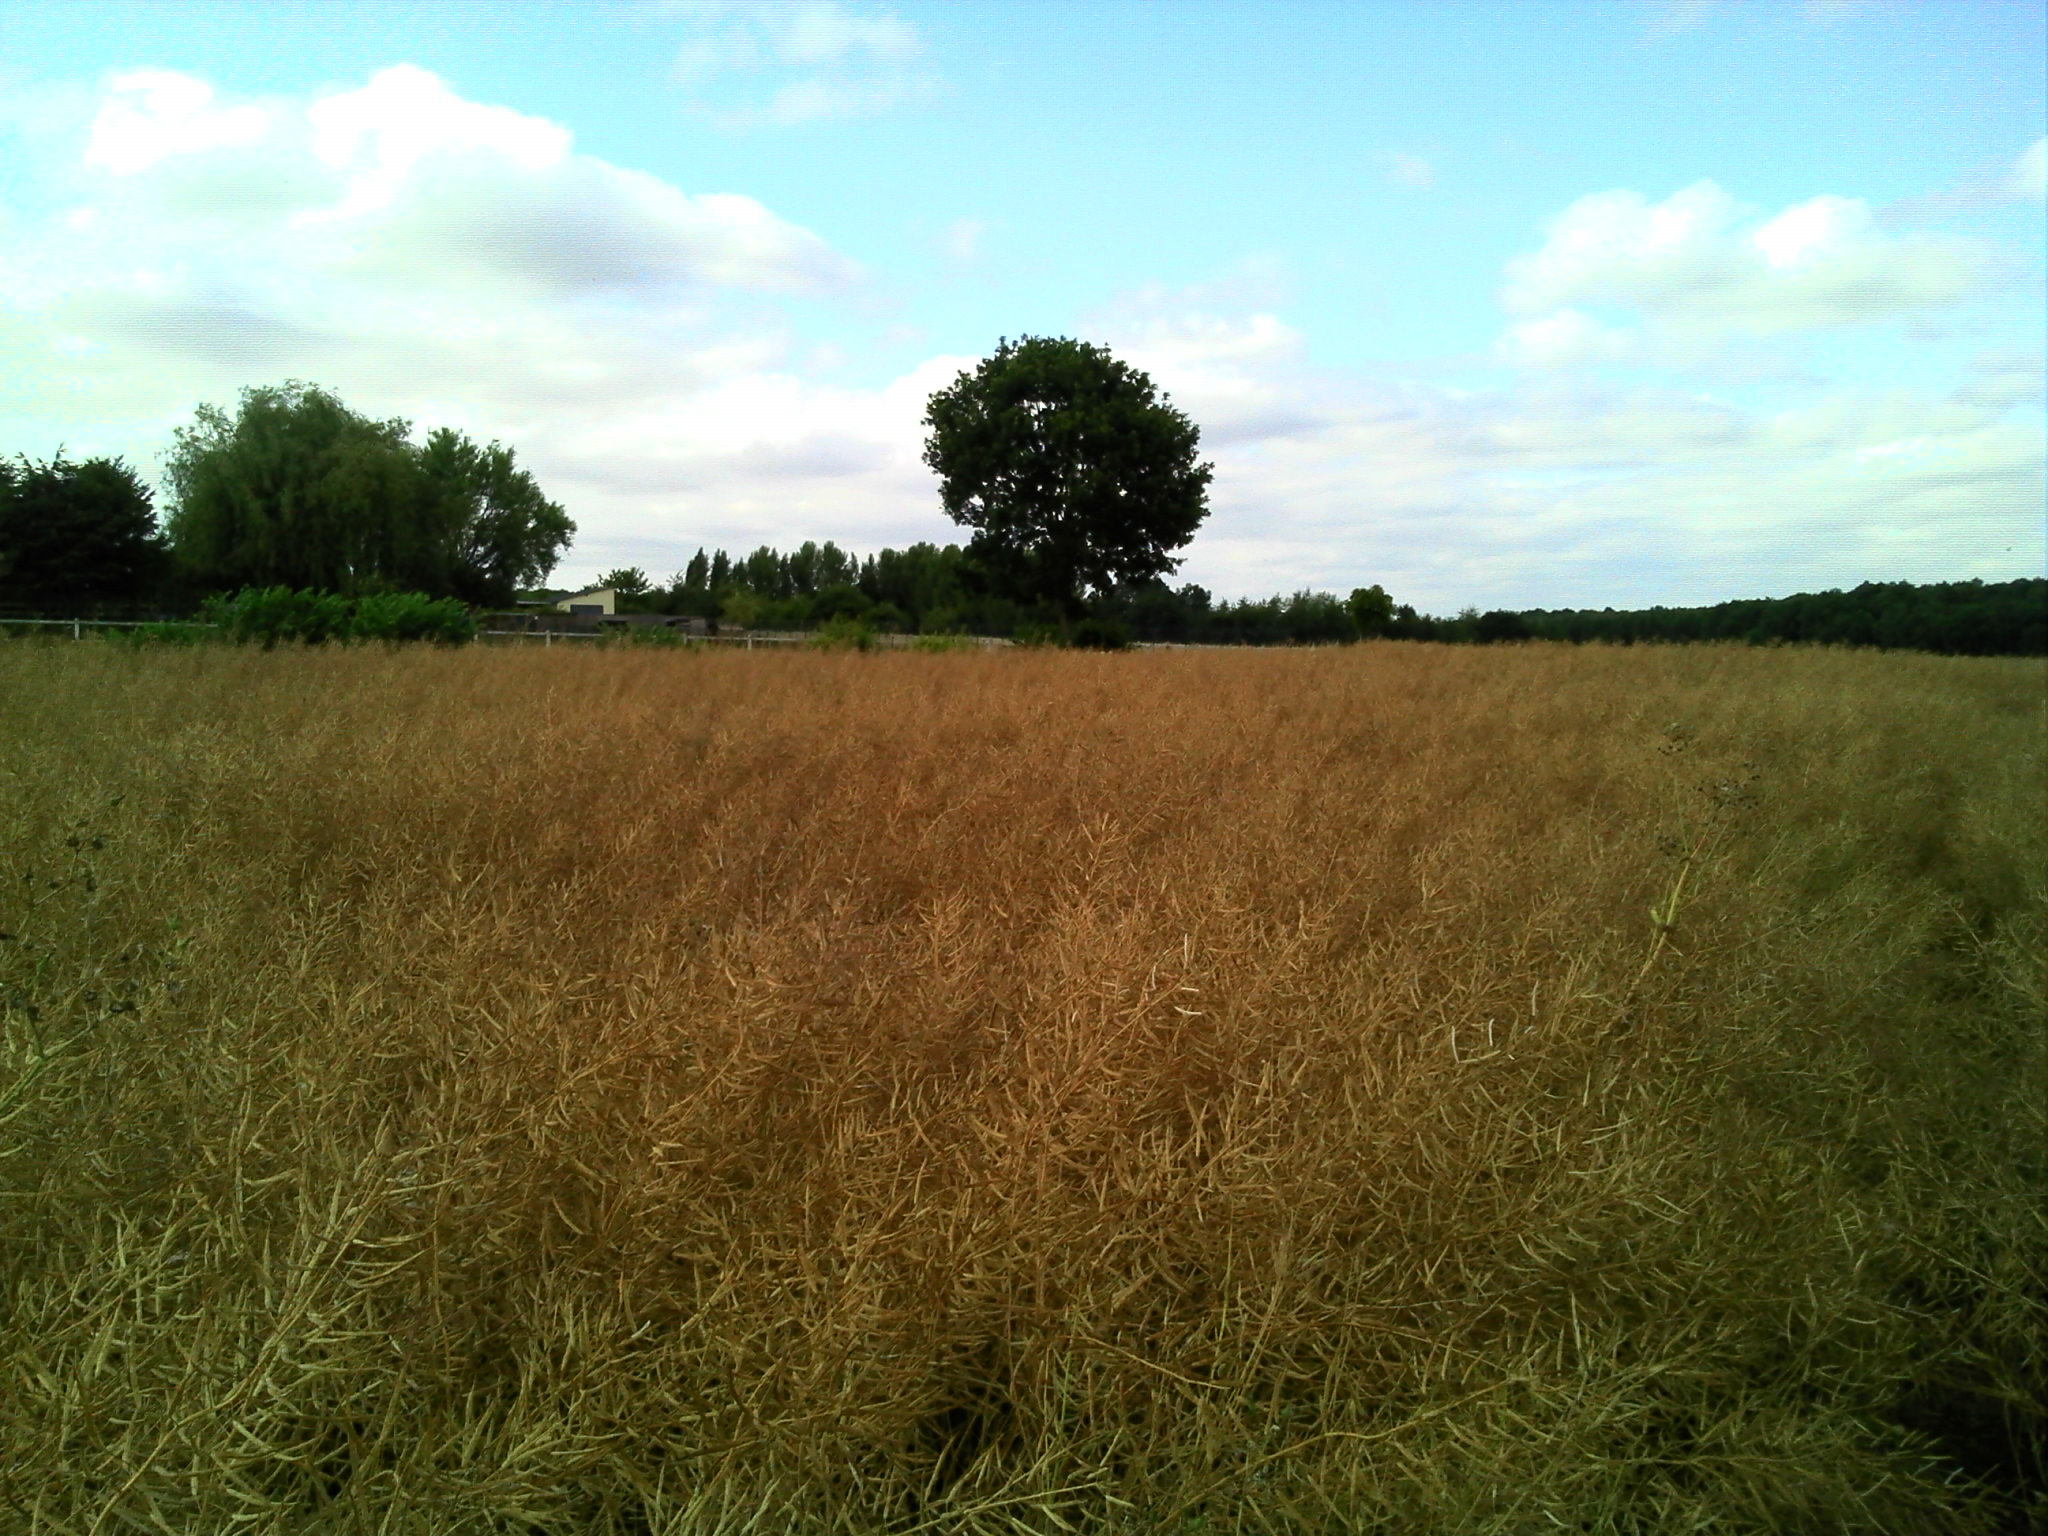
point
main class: Cropland
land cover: Rape and turnip rape
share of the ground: > 75 %
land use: Agriculture (excluding fallow land and kitchen gardens)
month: July
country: FR
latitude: 48.9482
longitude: 1.0900
